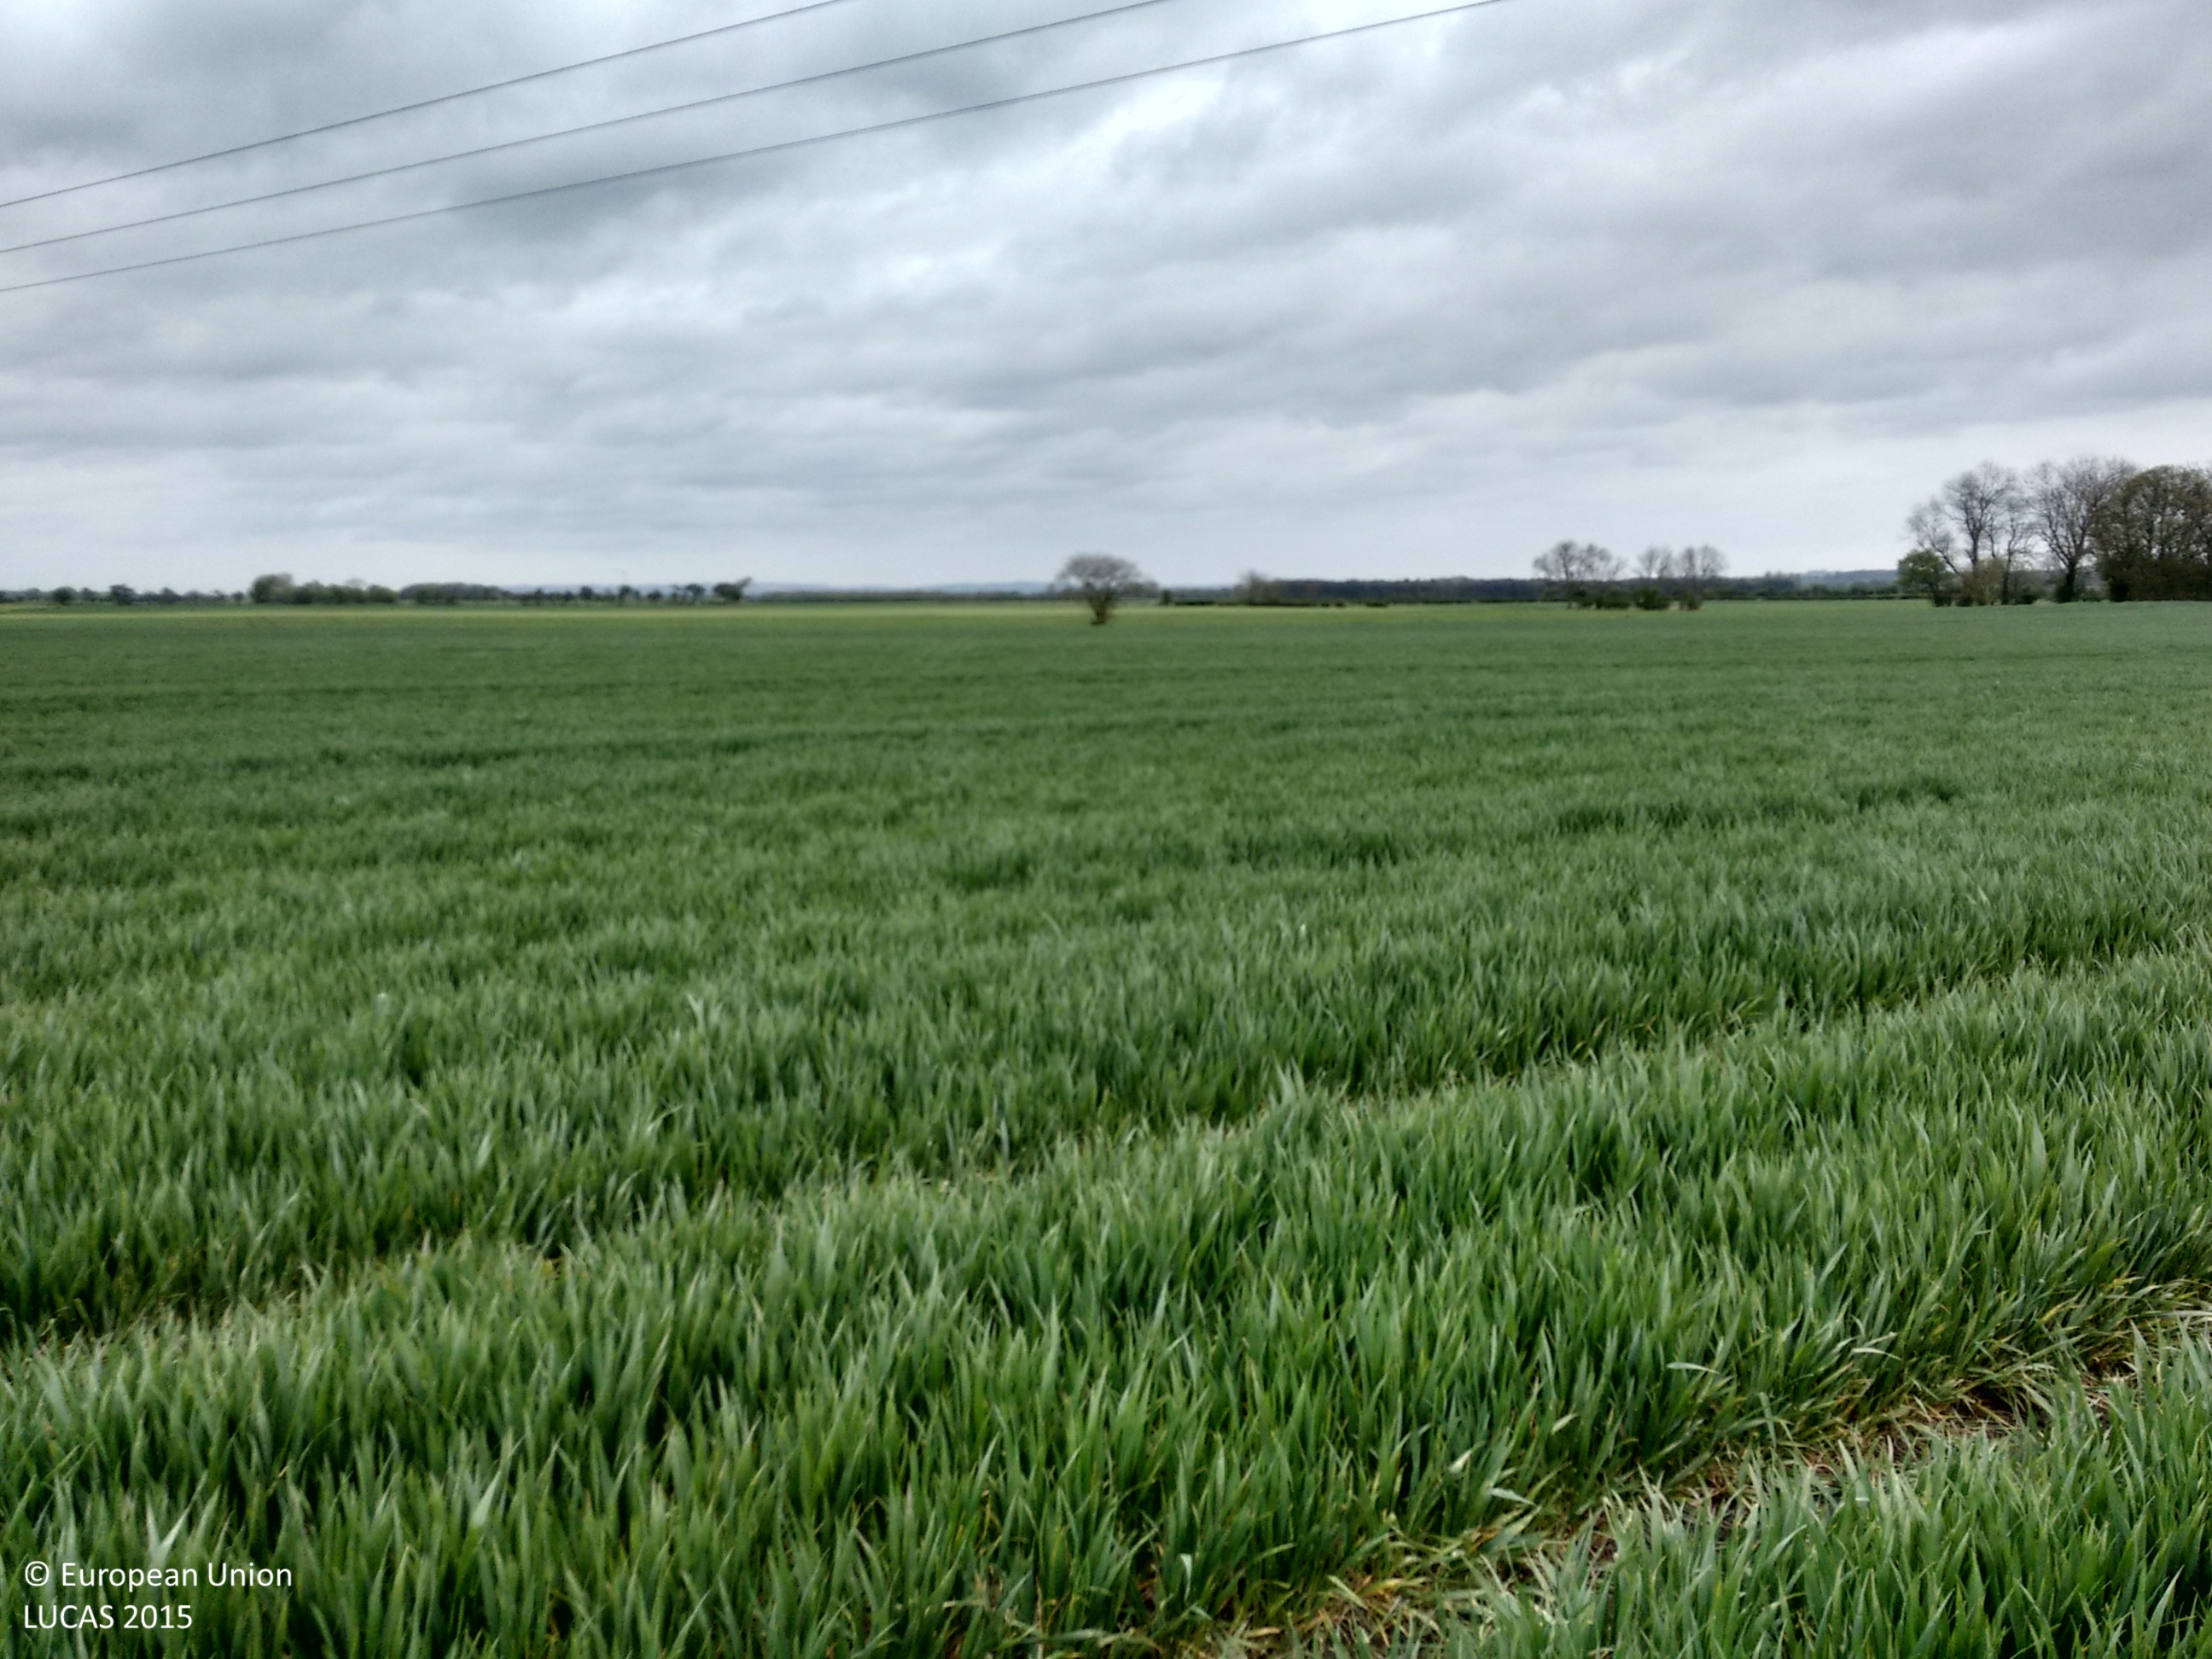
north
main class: Cropland
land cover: Barley
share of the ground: > 75 %
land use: Agriculture (excluding fallow land and kitchen gardens)
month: May
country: GB
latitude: 53.7784
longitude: -0.7075
